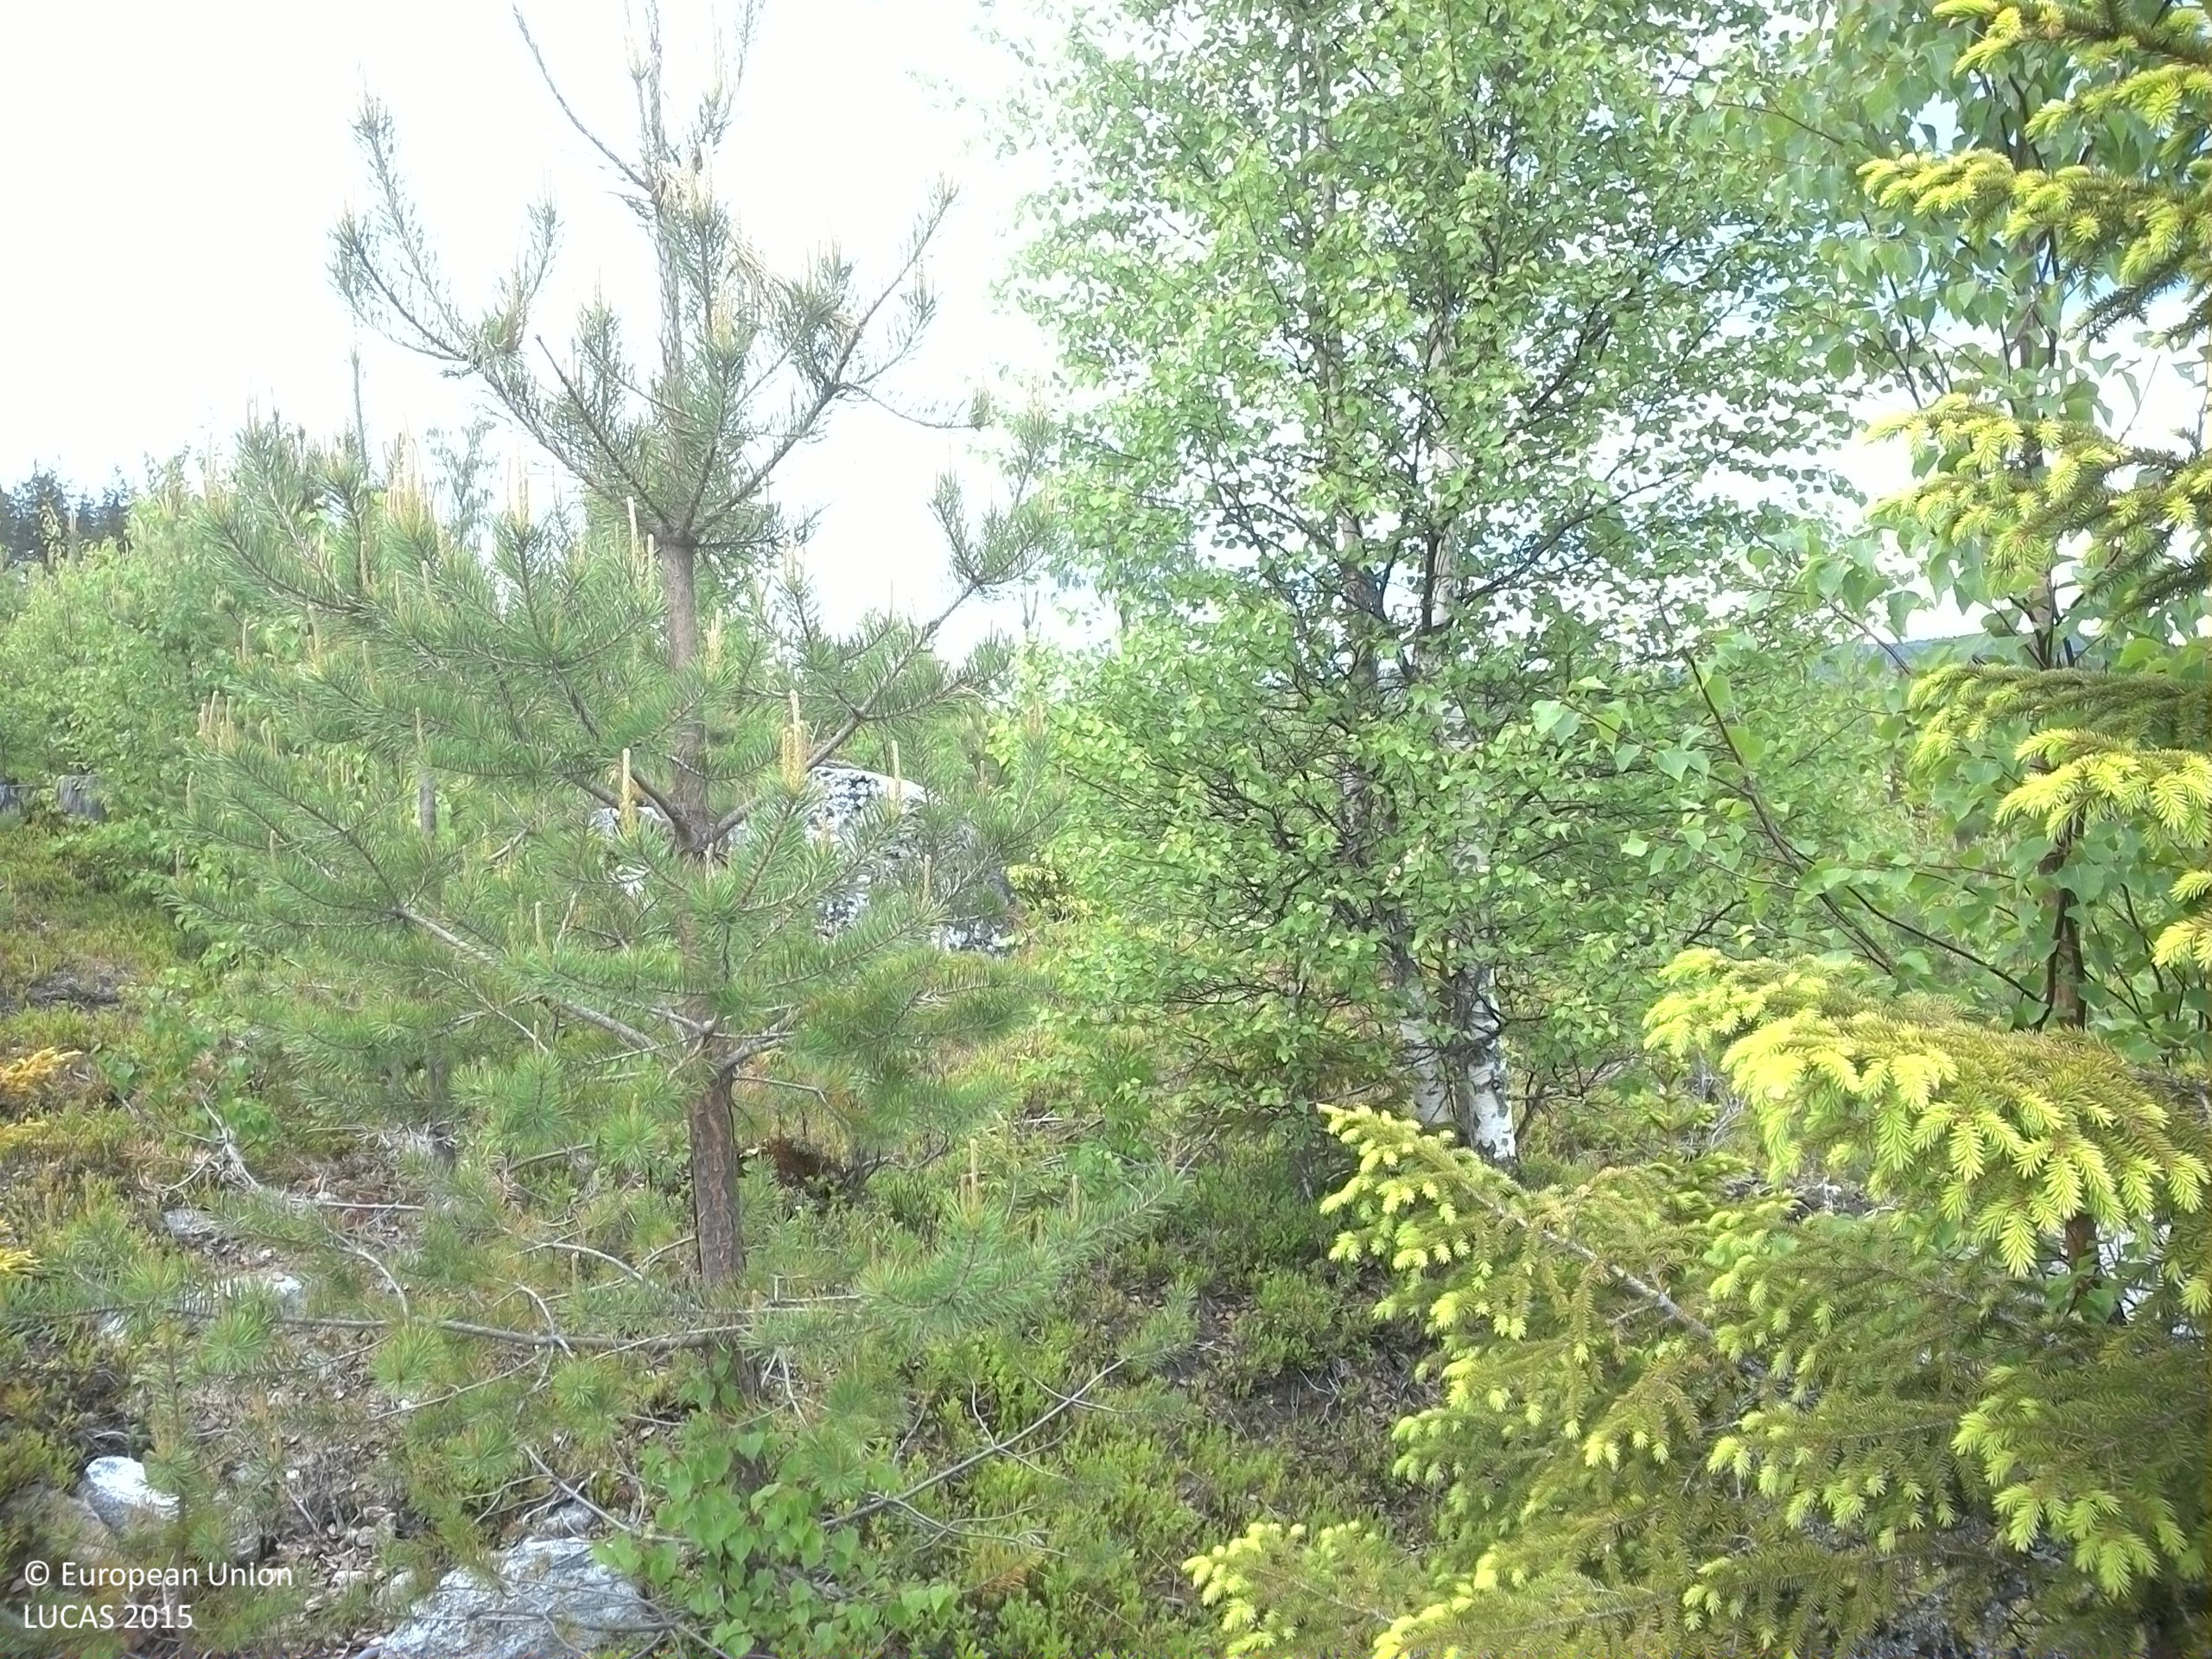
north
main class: Woodland
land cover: Pine dominated mixed woodland
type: exotic forest
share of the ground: 50 - 75 %
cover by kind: shrubs 45 %, coniferous forest trees 35 %, broadleaved forest trees 20 %
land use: Forestry
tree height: < 5 m
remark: Clear cut
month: June
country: SE
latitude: 63.4805
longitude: 18.1454
